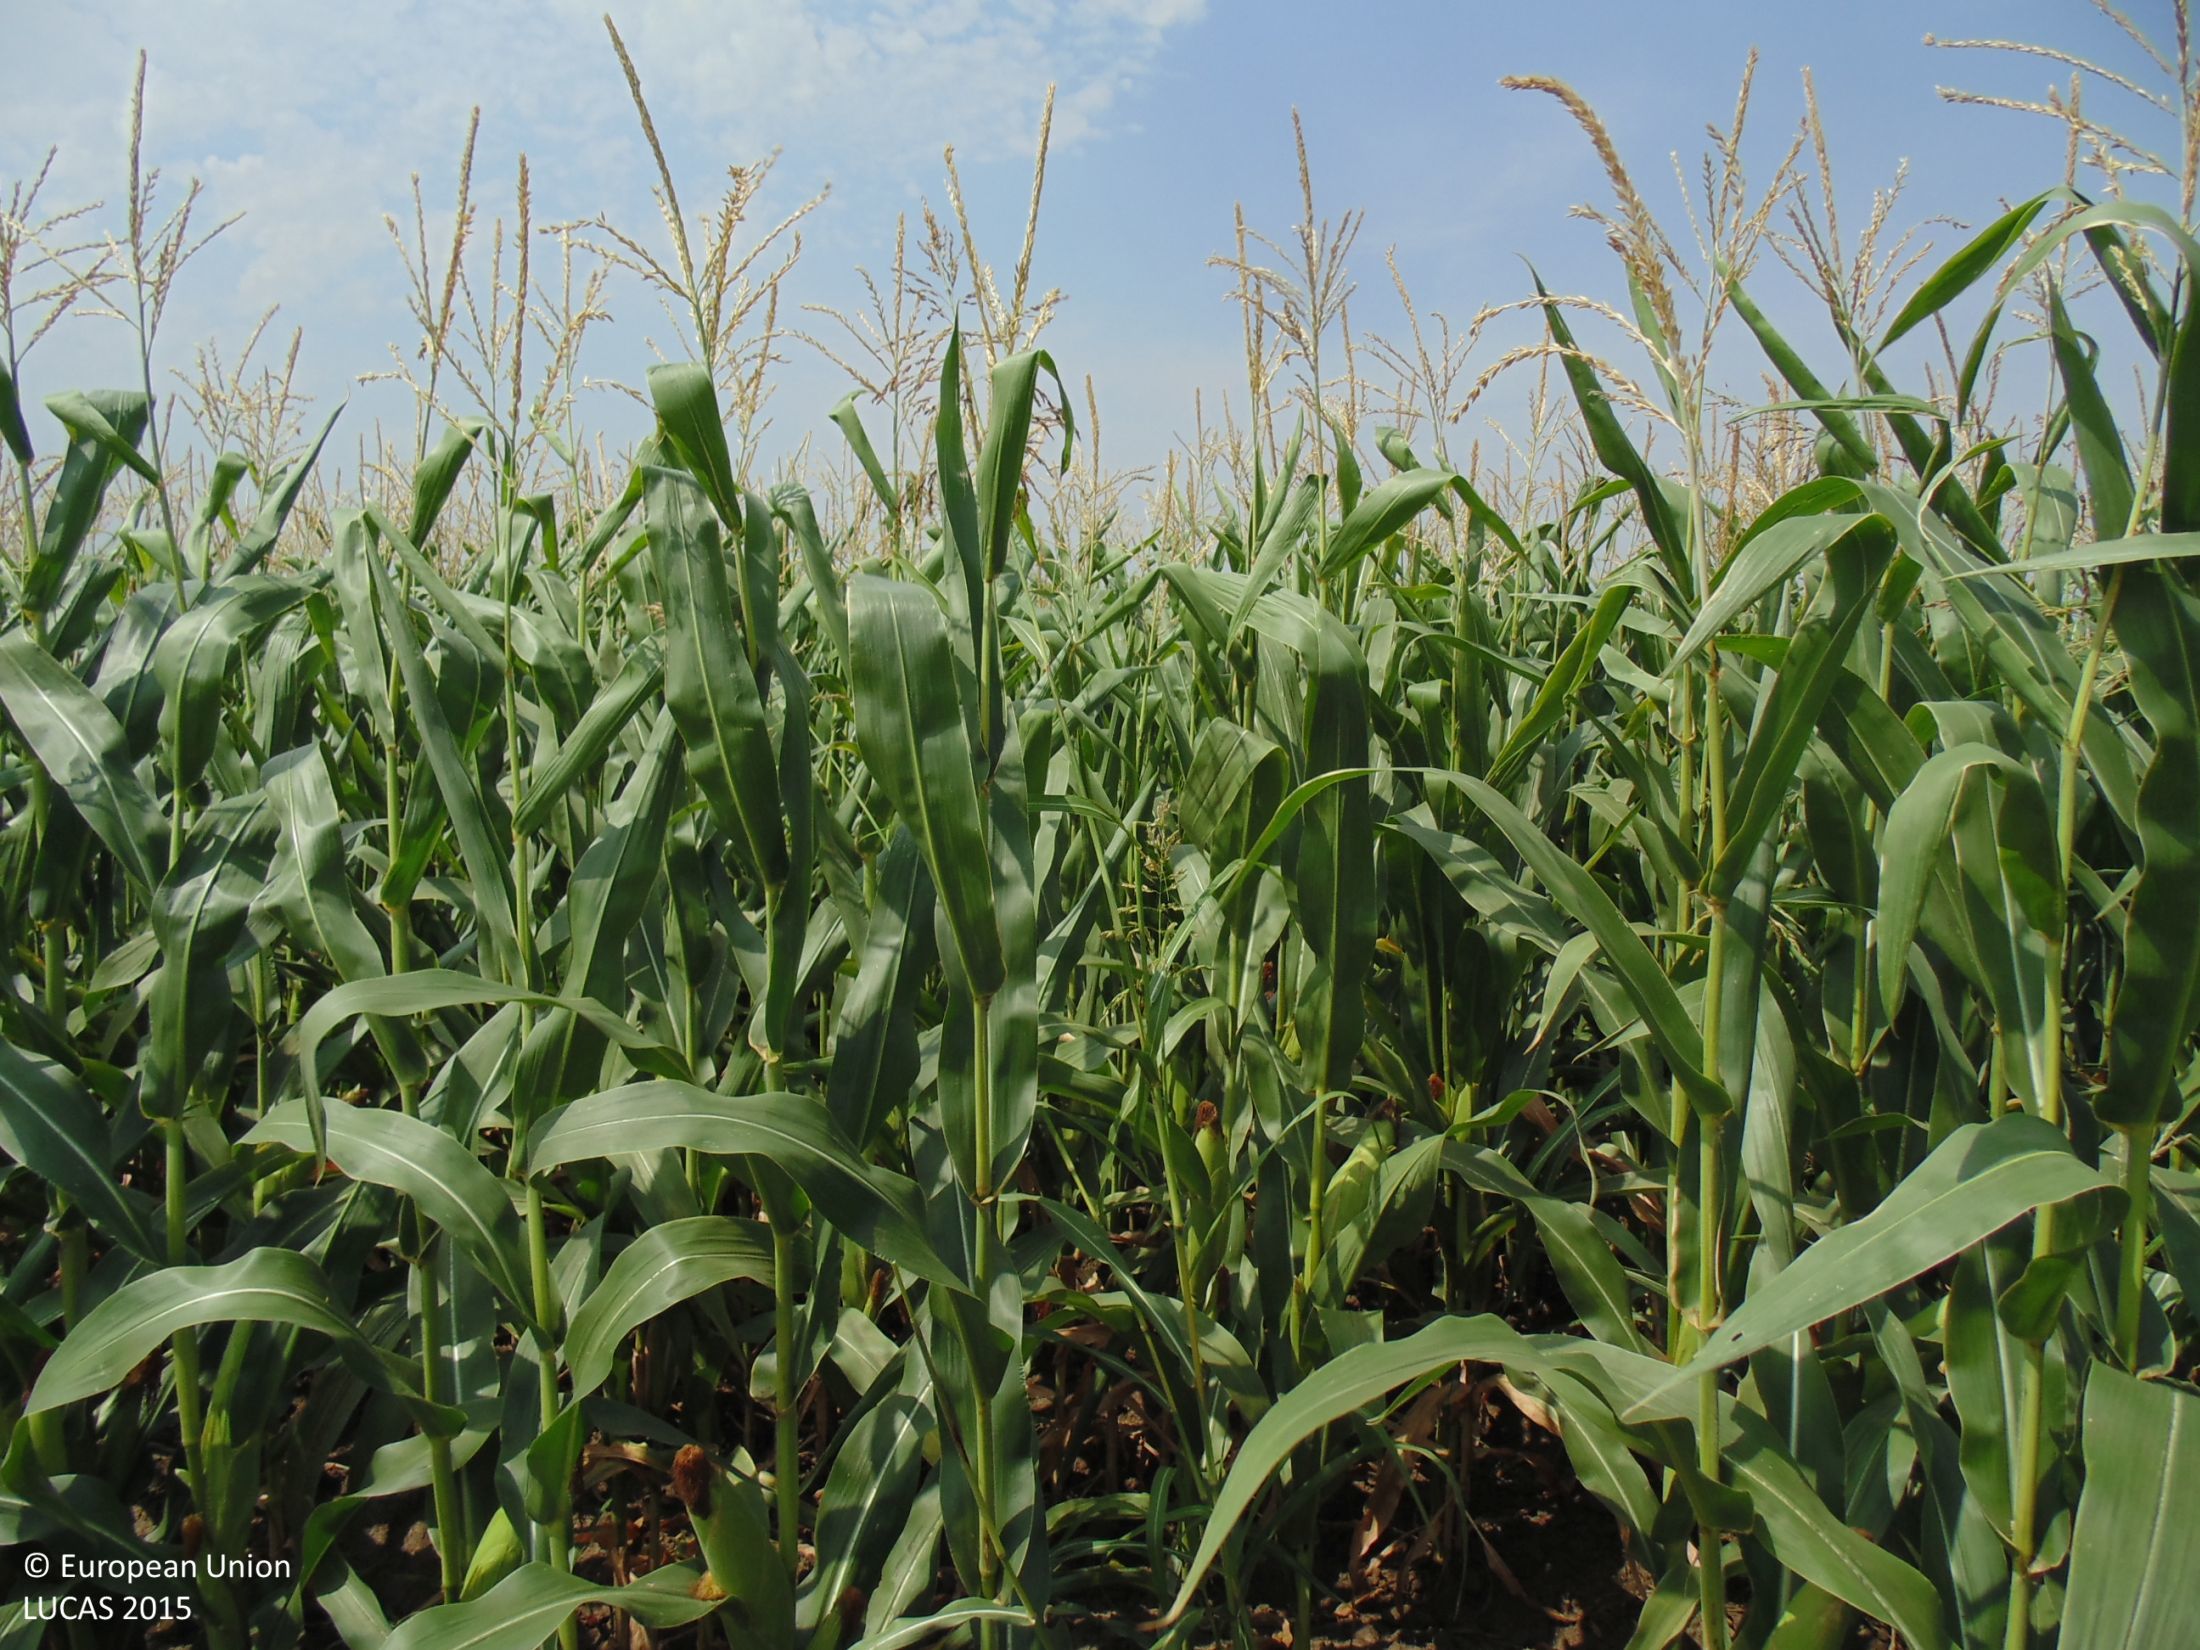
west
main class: Cropland
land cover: Maize
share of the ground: > 75 %
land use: Agriculture (excluding fallow land and kitchen gardens)
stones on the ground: < 10 %
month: August
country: BG
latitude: 43.7922
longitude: 28.1105
